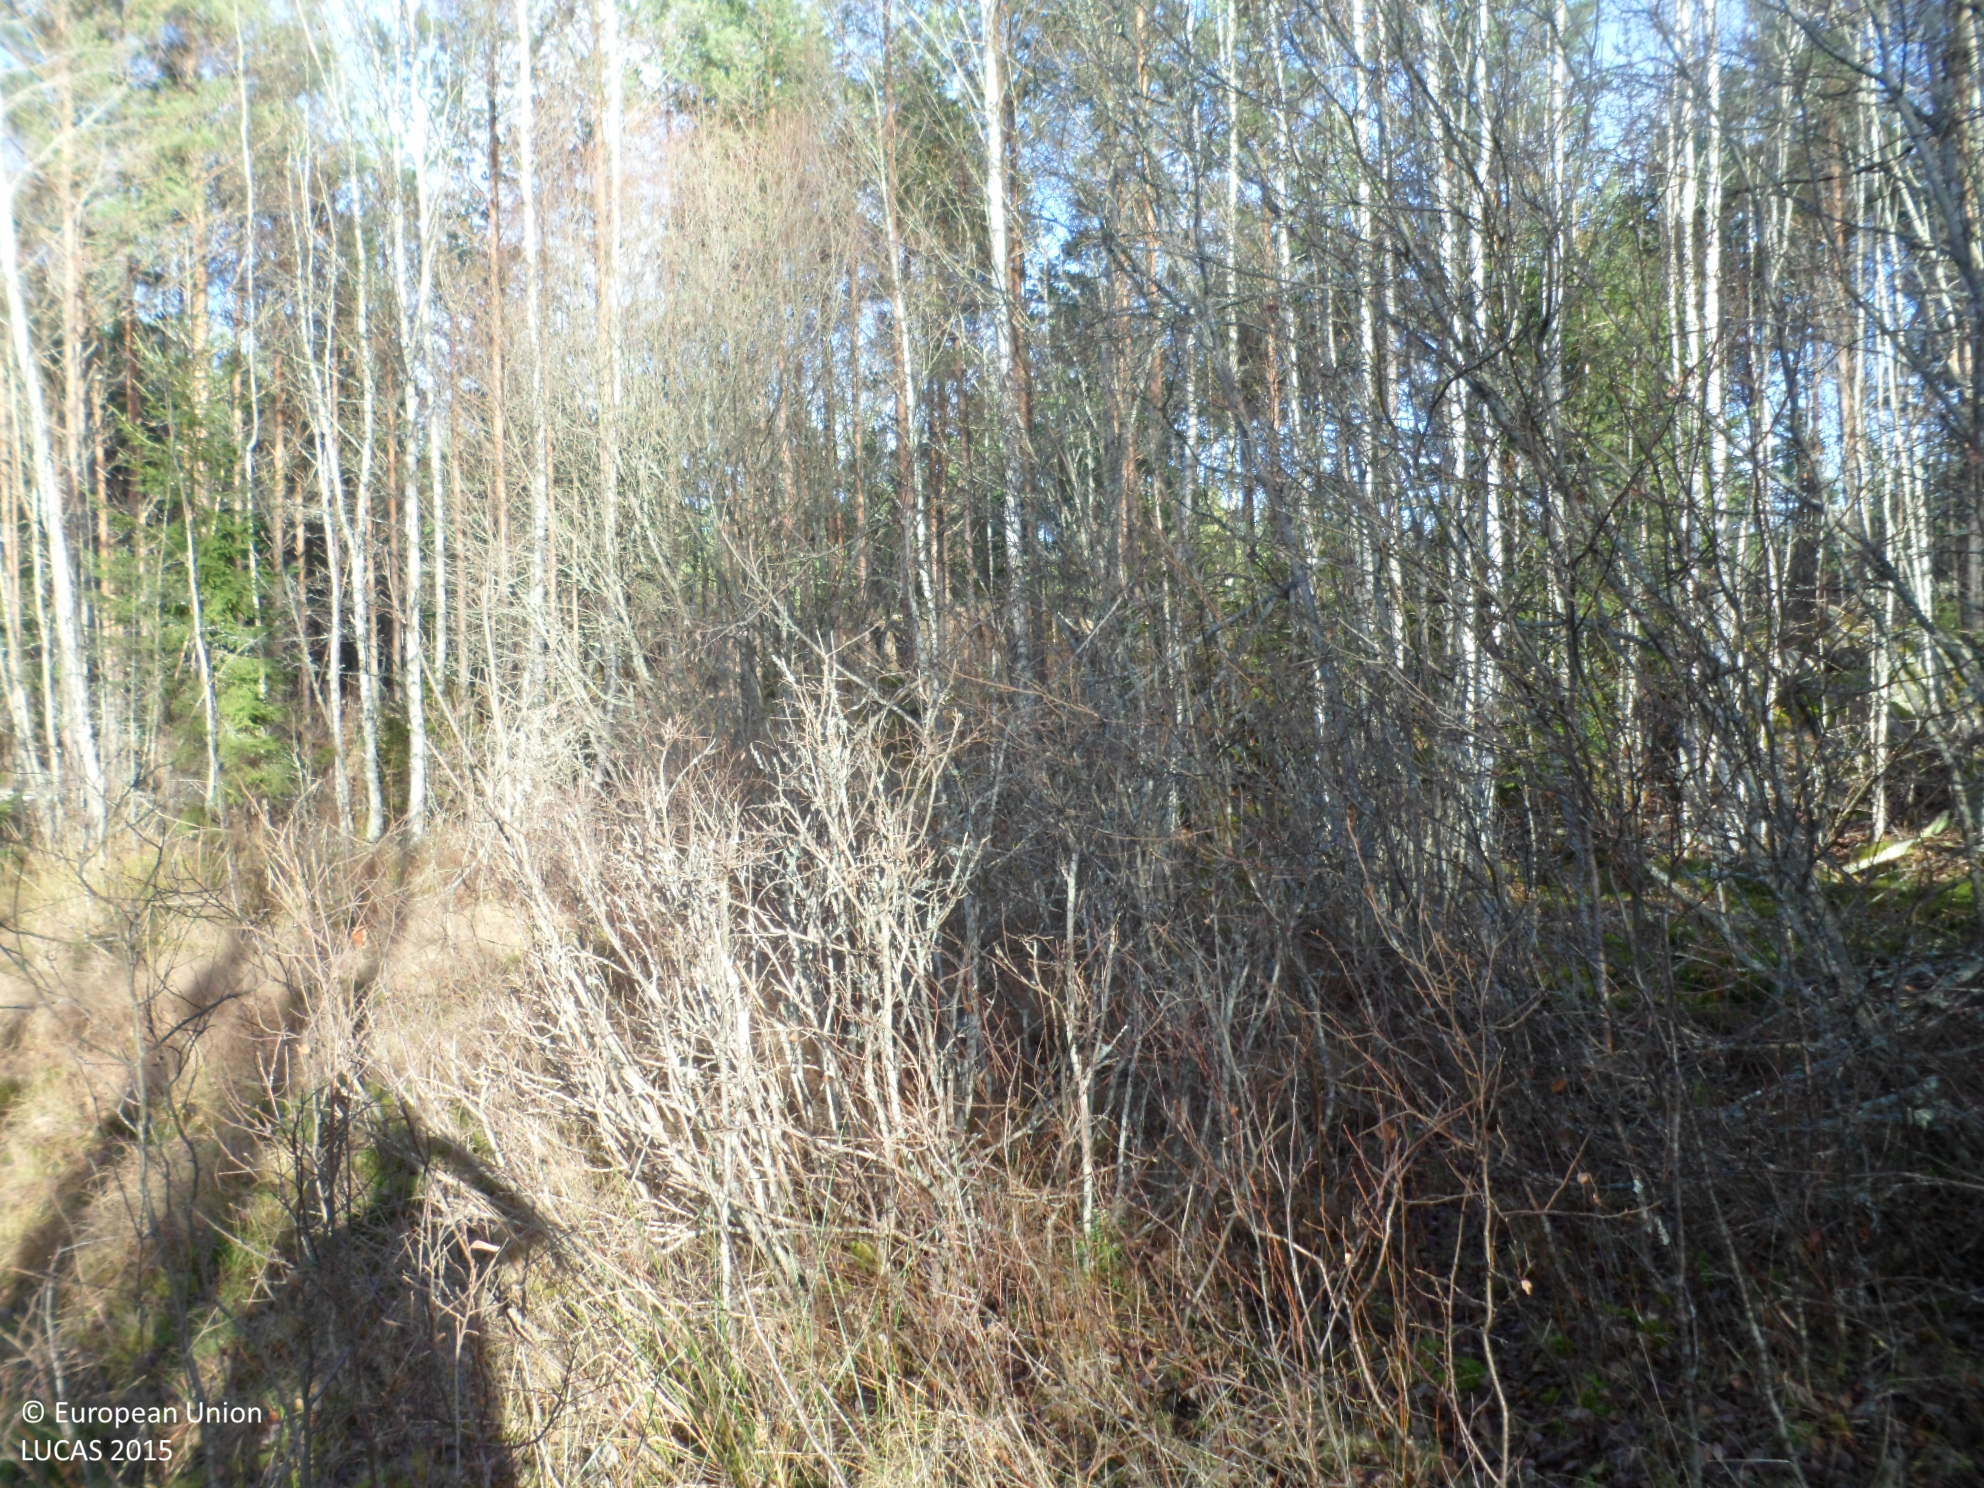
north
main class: Woodland
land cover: Broadleaved woodland
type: boreal forest
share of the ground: 50 - 75 %
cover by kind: broadleaved forest trees 50 %, shrubs 25 %, herbaceous plants 10 %, lichens and mosses 10 %, coniferous forest trees 5 %
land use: Forestry
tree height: > 5 m
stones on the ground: < 10 %
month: November
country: SE
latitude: 57.2310
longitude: 16.1447
